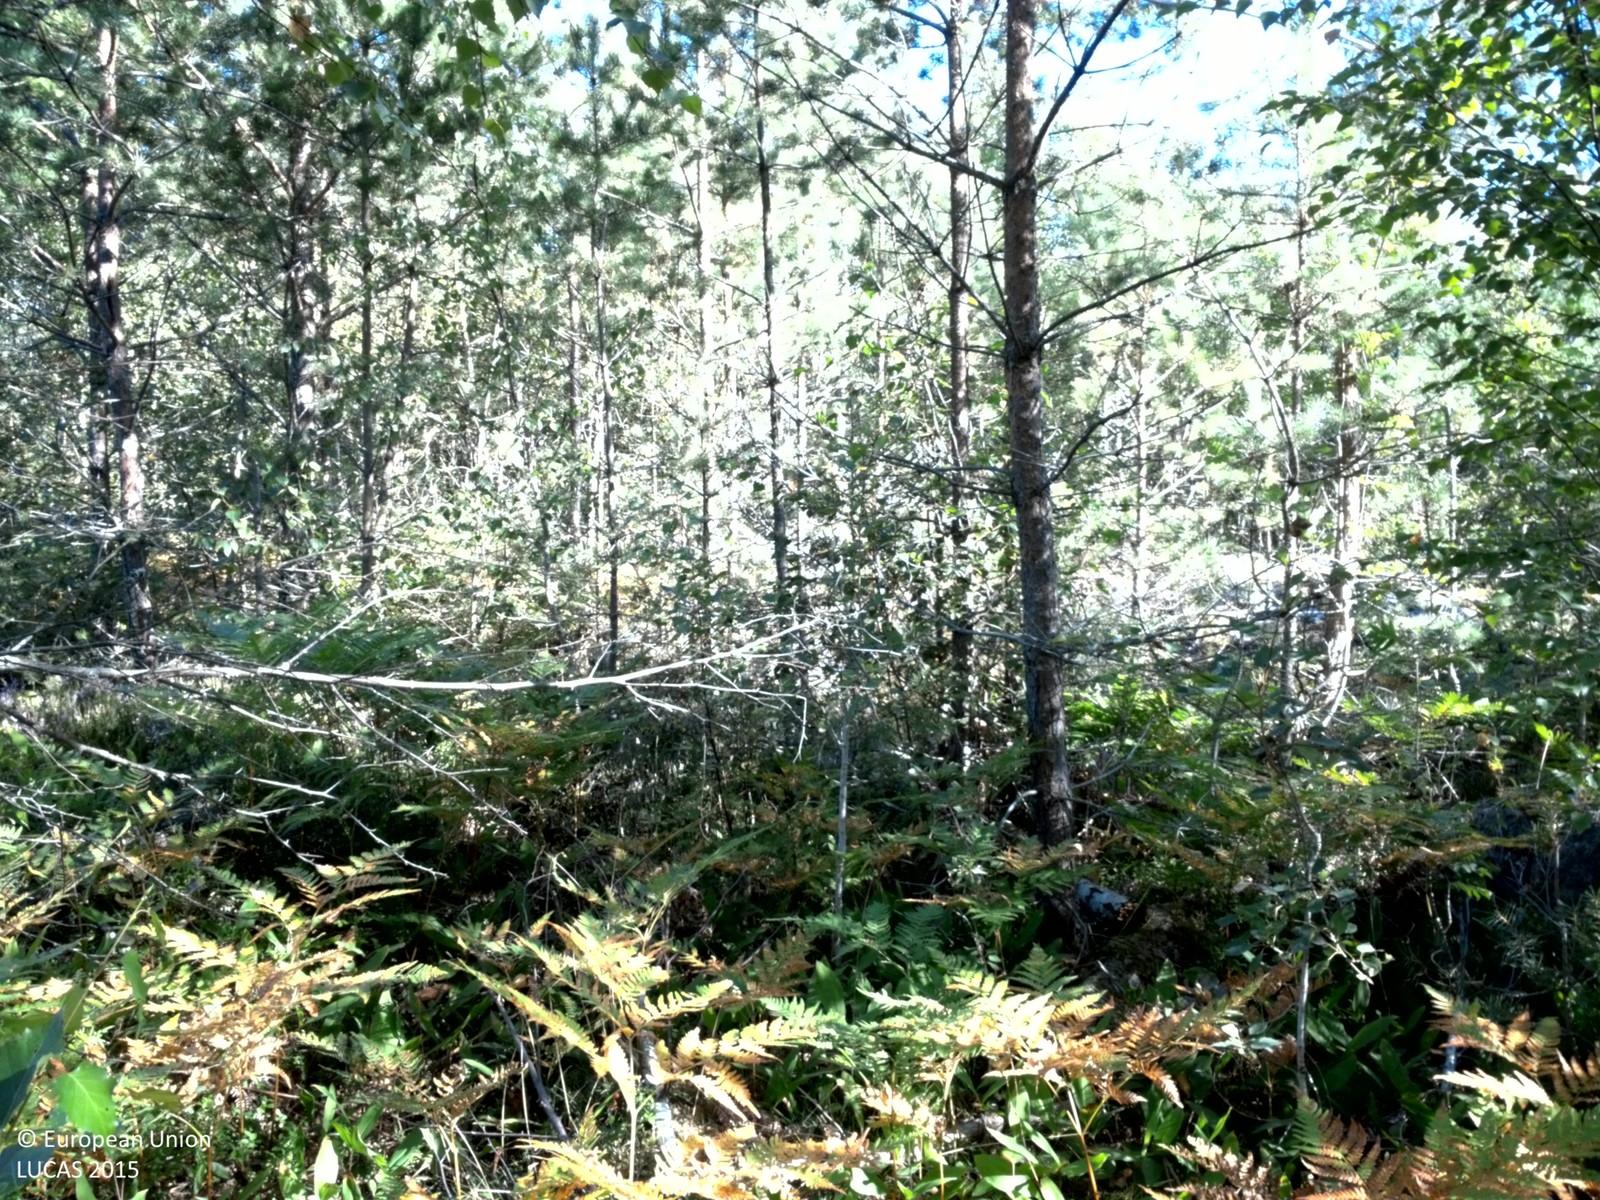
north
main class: Woodland
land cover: Pine dominated mixed woodland
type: boreal forest
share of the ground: 50 - 75 %
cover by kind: coniferous forest trees 30 %, herbaceous plants 30 %, broadleaved forest trees 25 %, shrubs 15 %
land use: Forestry
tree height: < 5 m
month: August
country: SE
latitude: 60.0427
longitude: 18.0202
